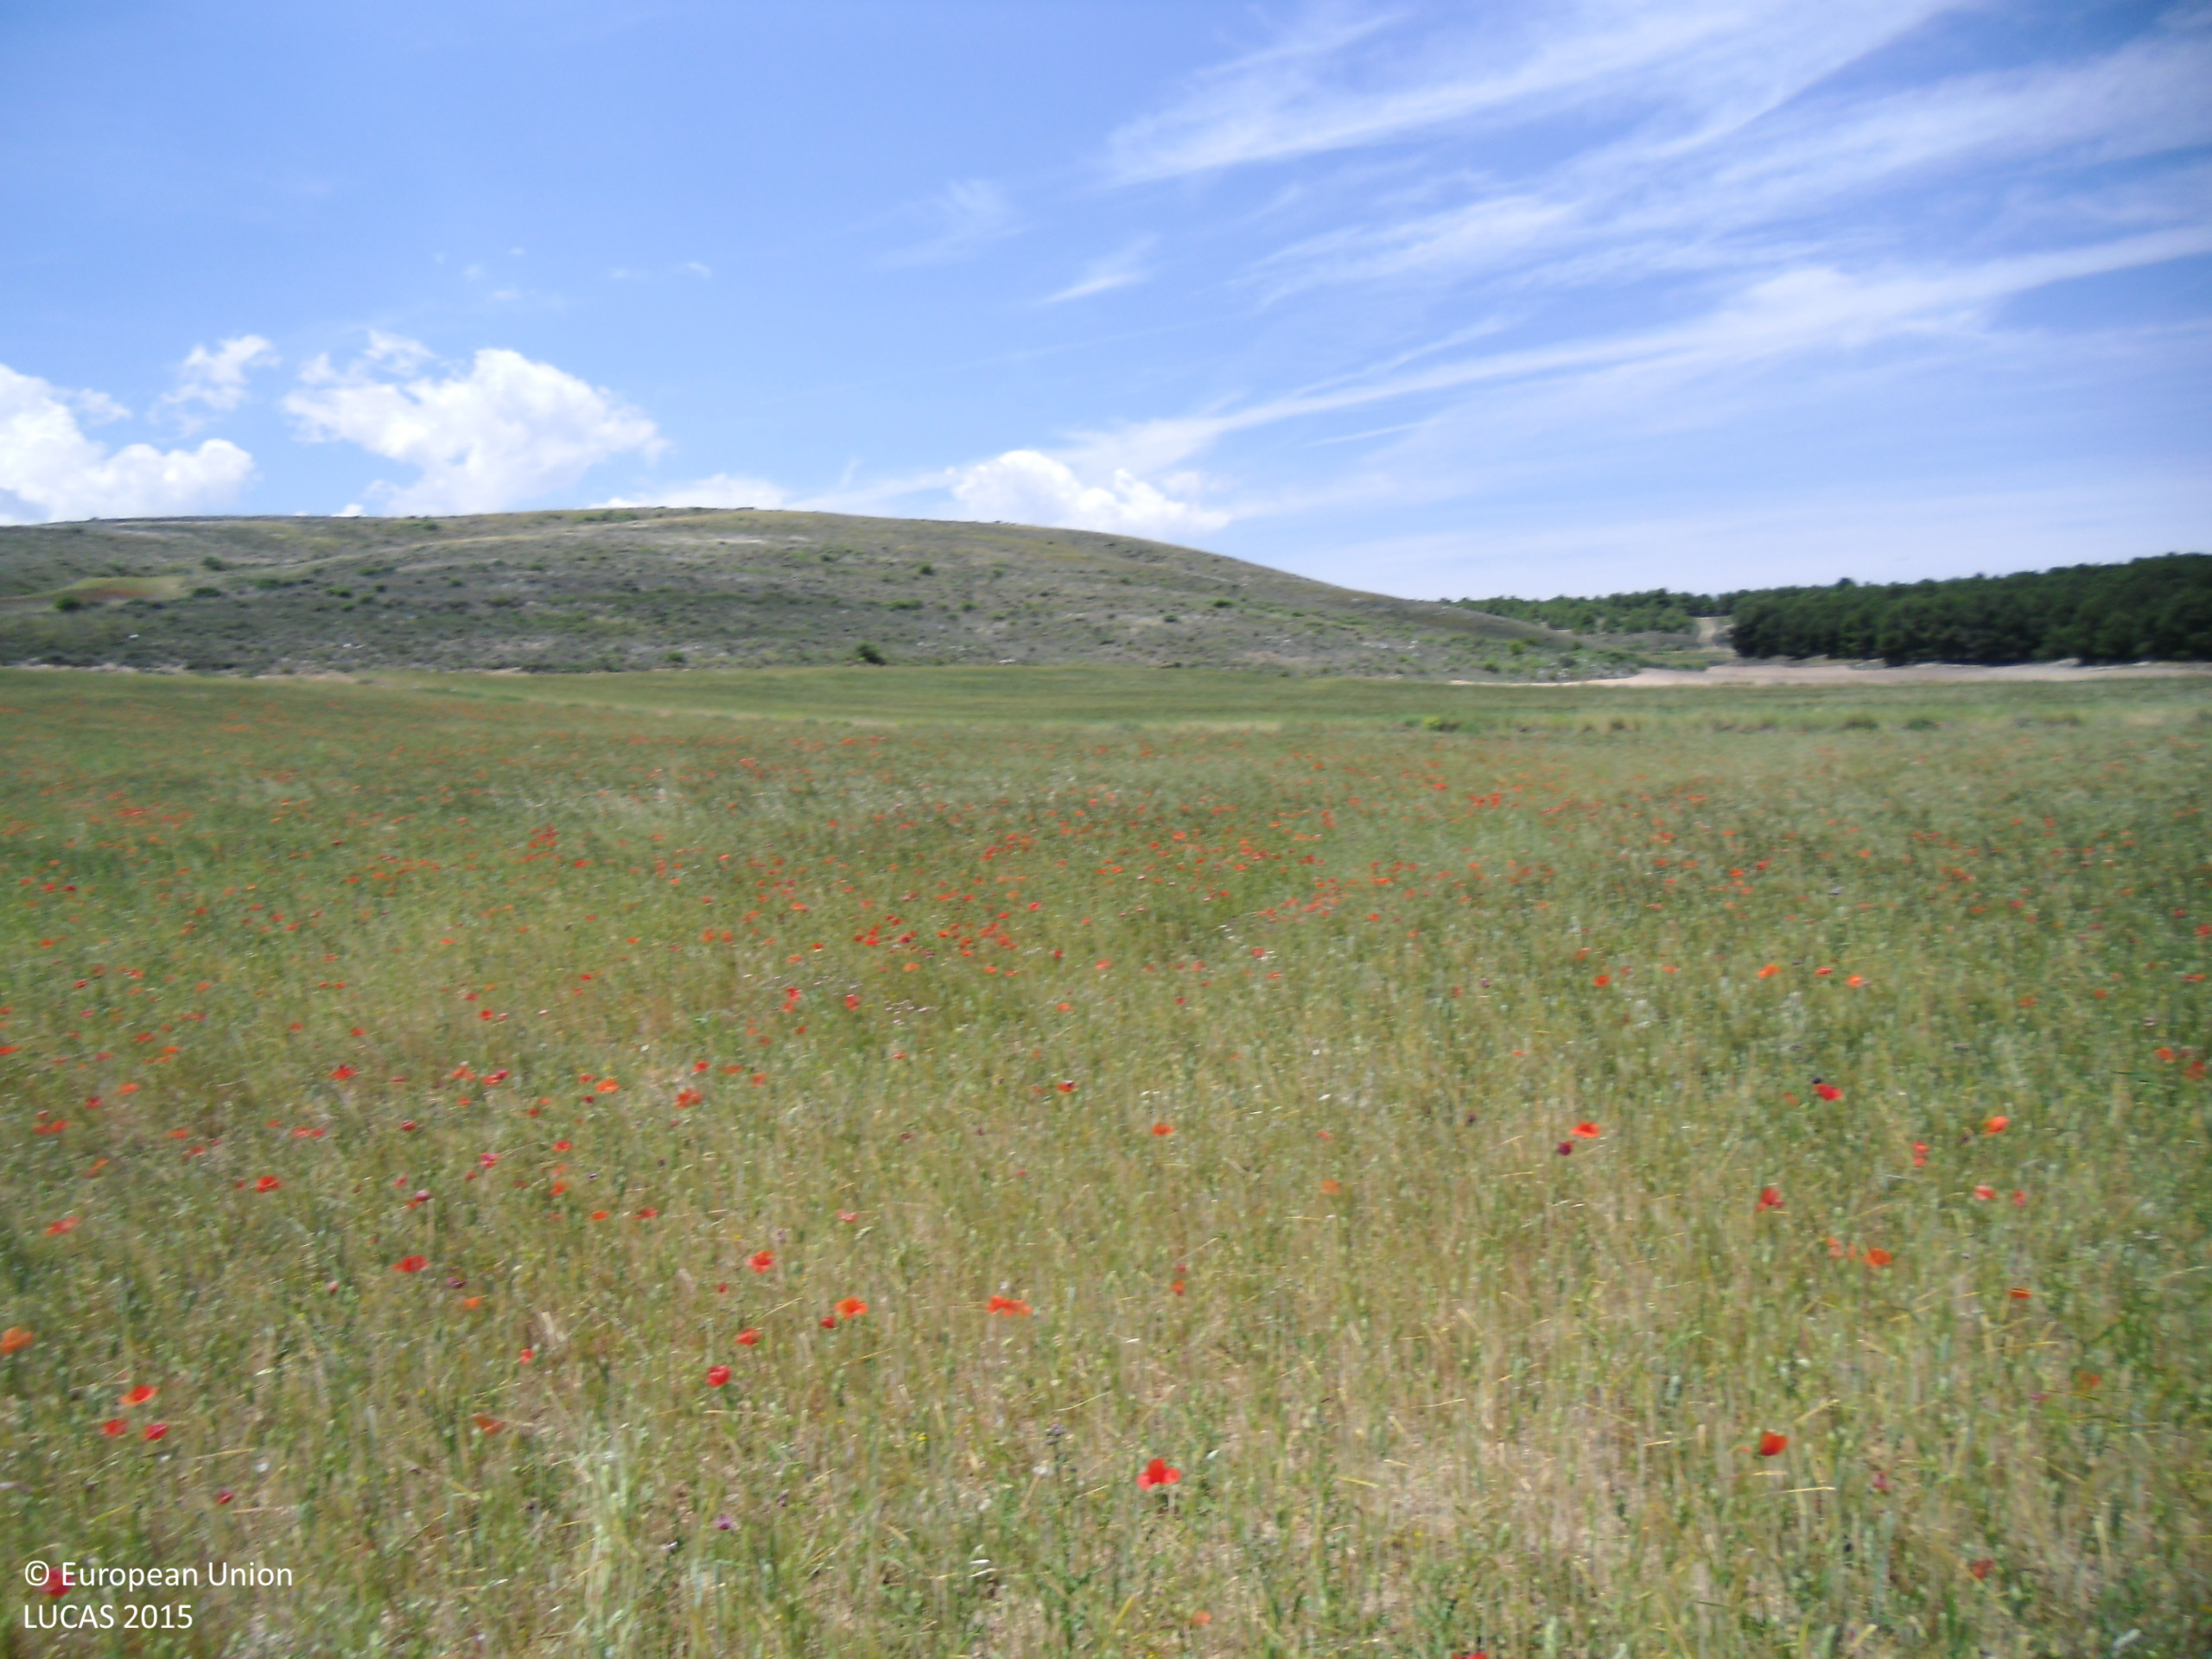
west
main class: Cropland
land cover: Mixed cereals for fodder
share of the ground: > 75 %
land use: Agriculture (excluding fallow land and kitchen gardens)
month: June
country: ES
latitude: 41.1000
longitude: -0.8873
